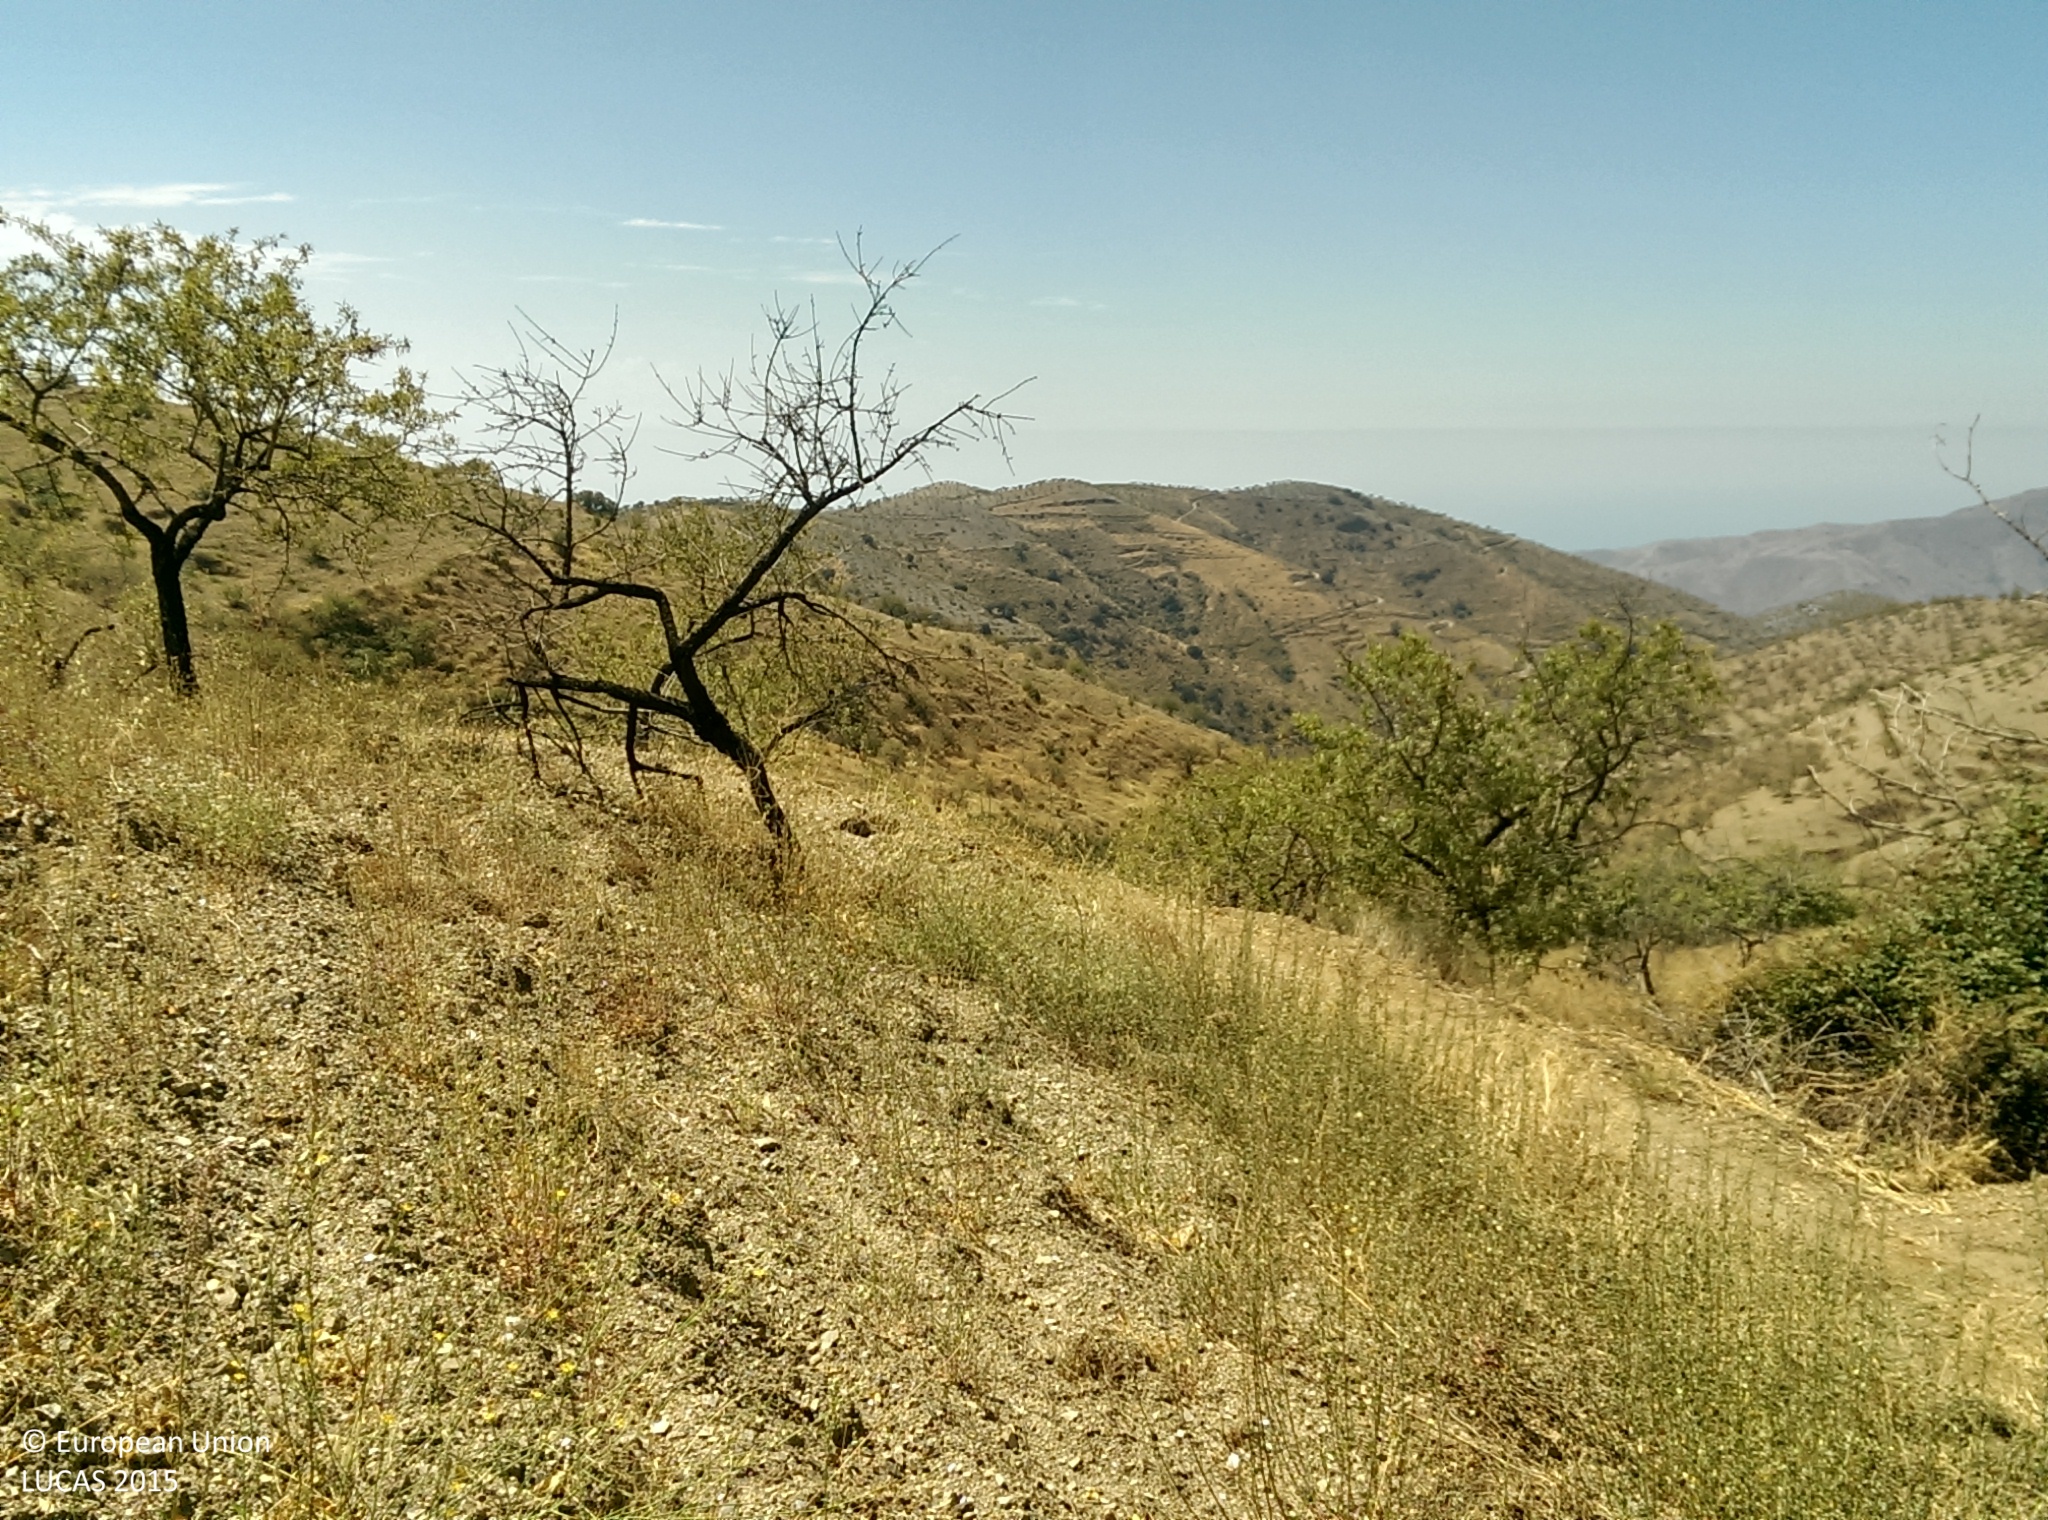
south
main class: Cropland
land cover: Nuts trees
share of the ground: 25 - 50 %
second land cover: Spontaneously vegetated surfaces
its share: 25 - 50 %
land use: Agriculture (excluding fallow land and kitchen gardens)
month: August
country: ES
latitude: 36.8295
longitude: -3.1539
